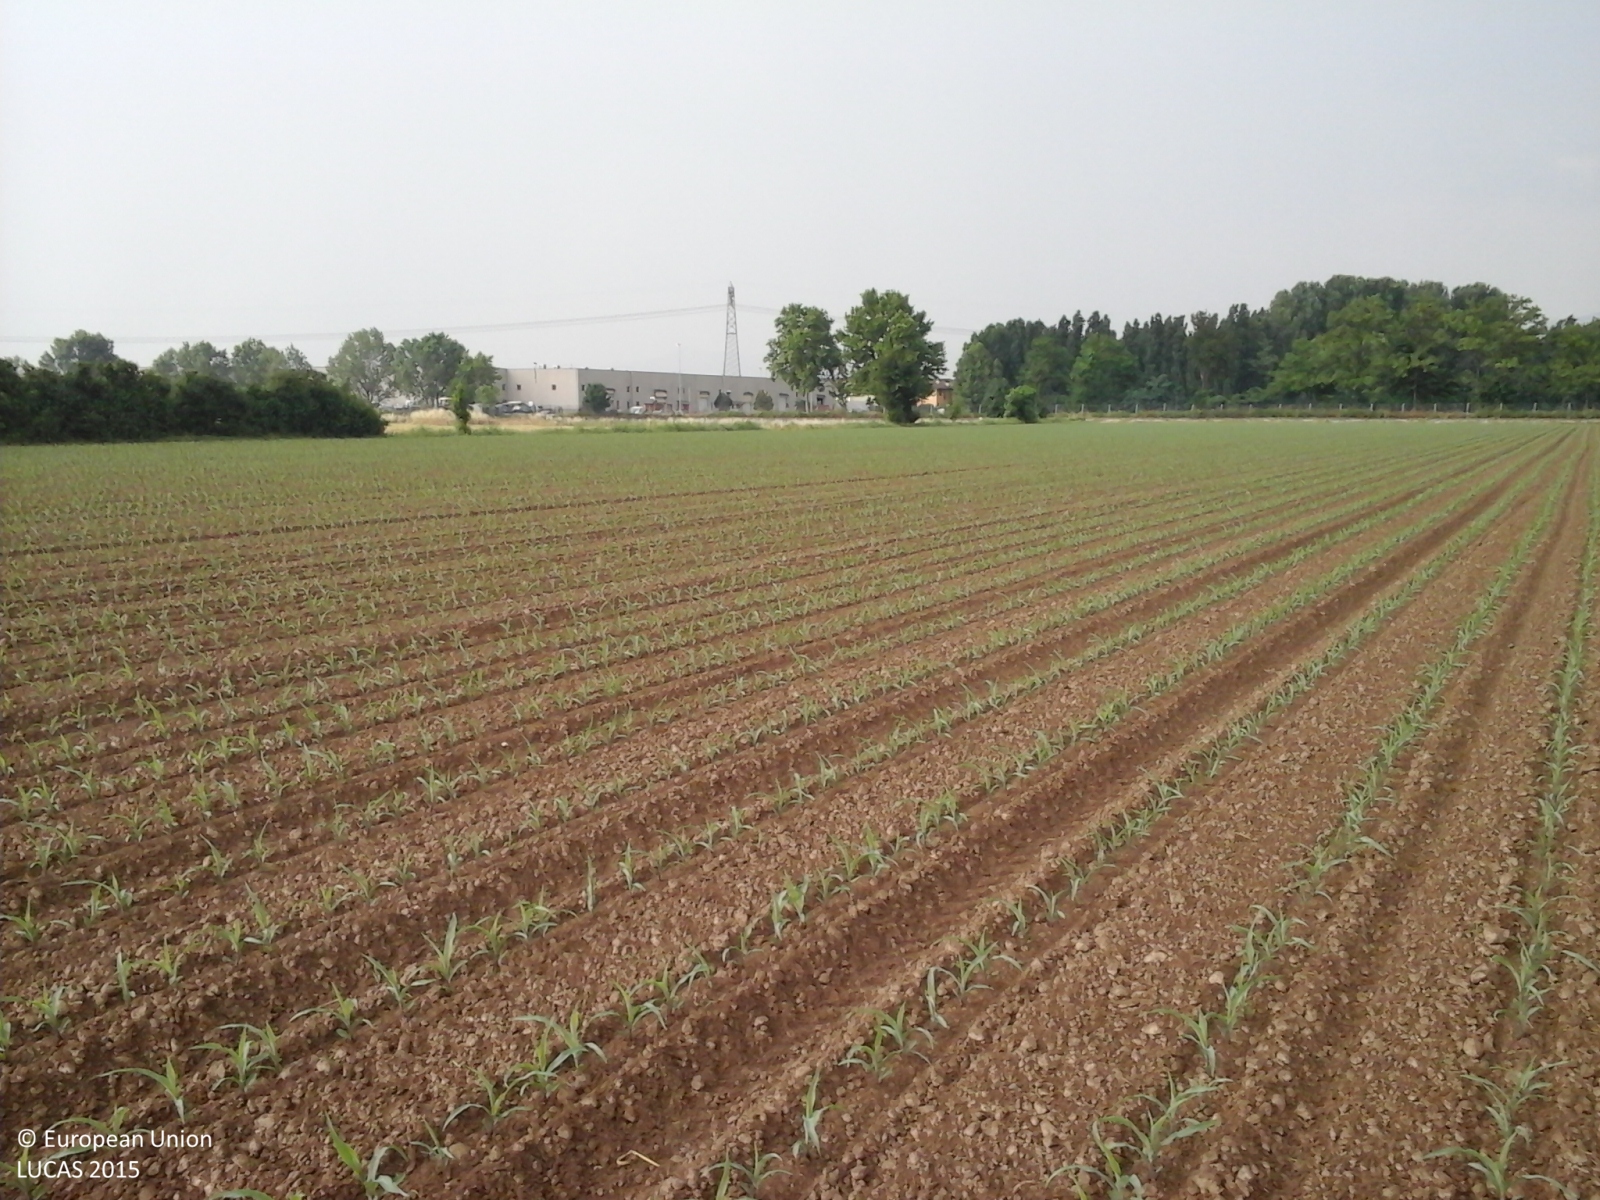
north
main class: Cropland
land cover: Maize
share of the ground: < 10 %
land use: Agriculture (excluding fallow land and kitchen gardens)
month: June
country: IT
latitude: 45.4862
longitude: 10.1660
